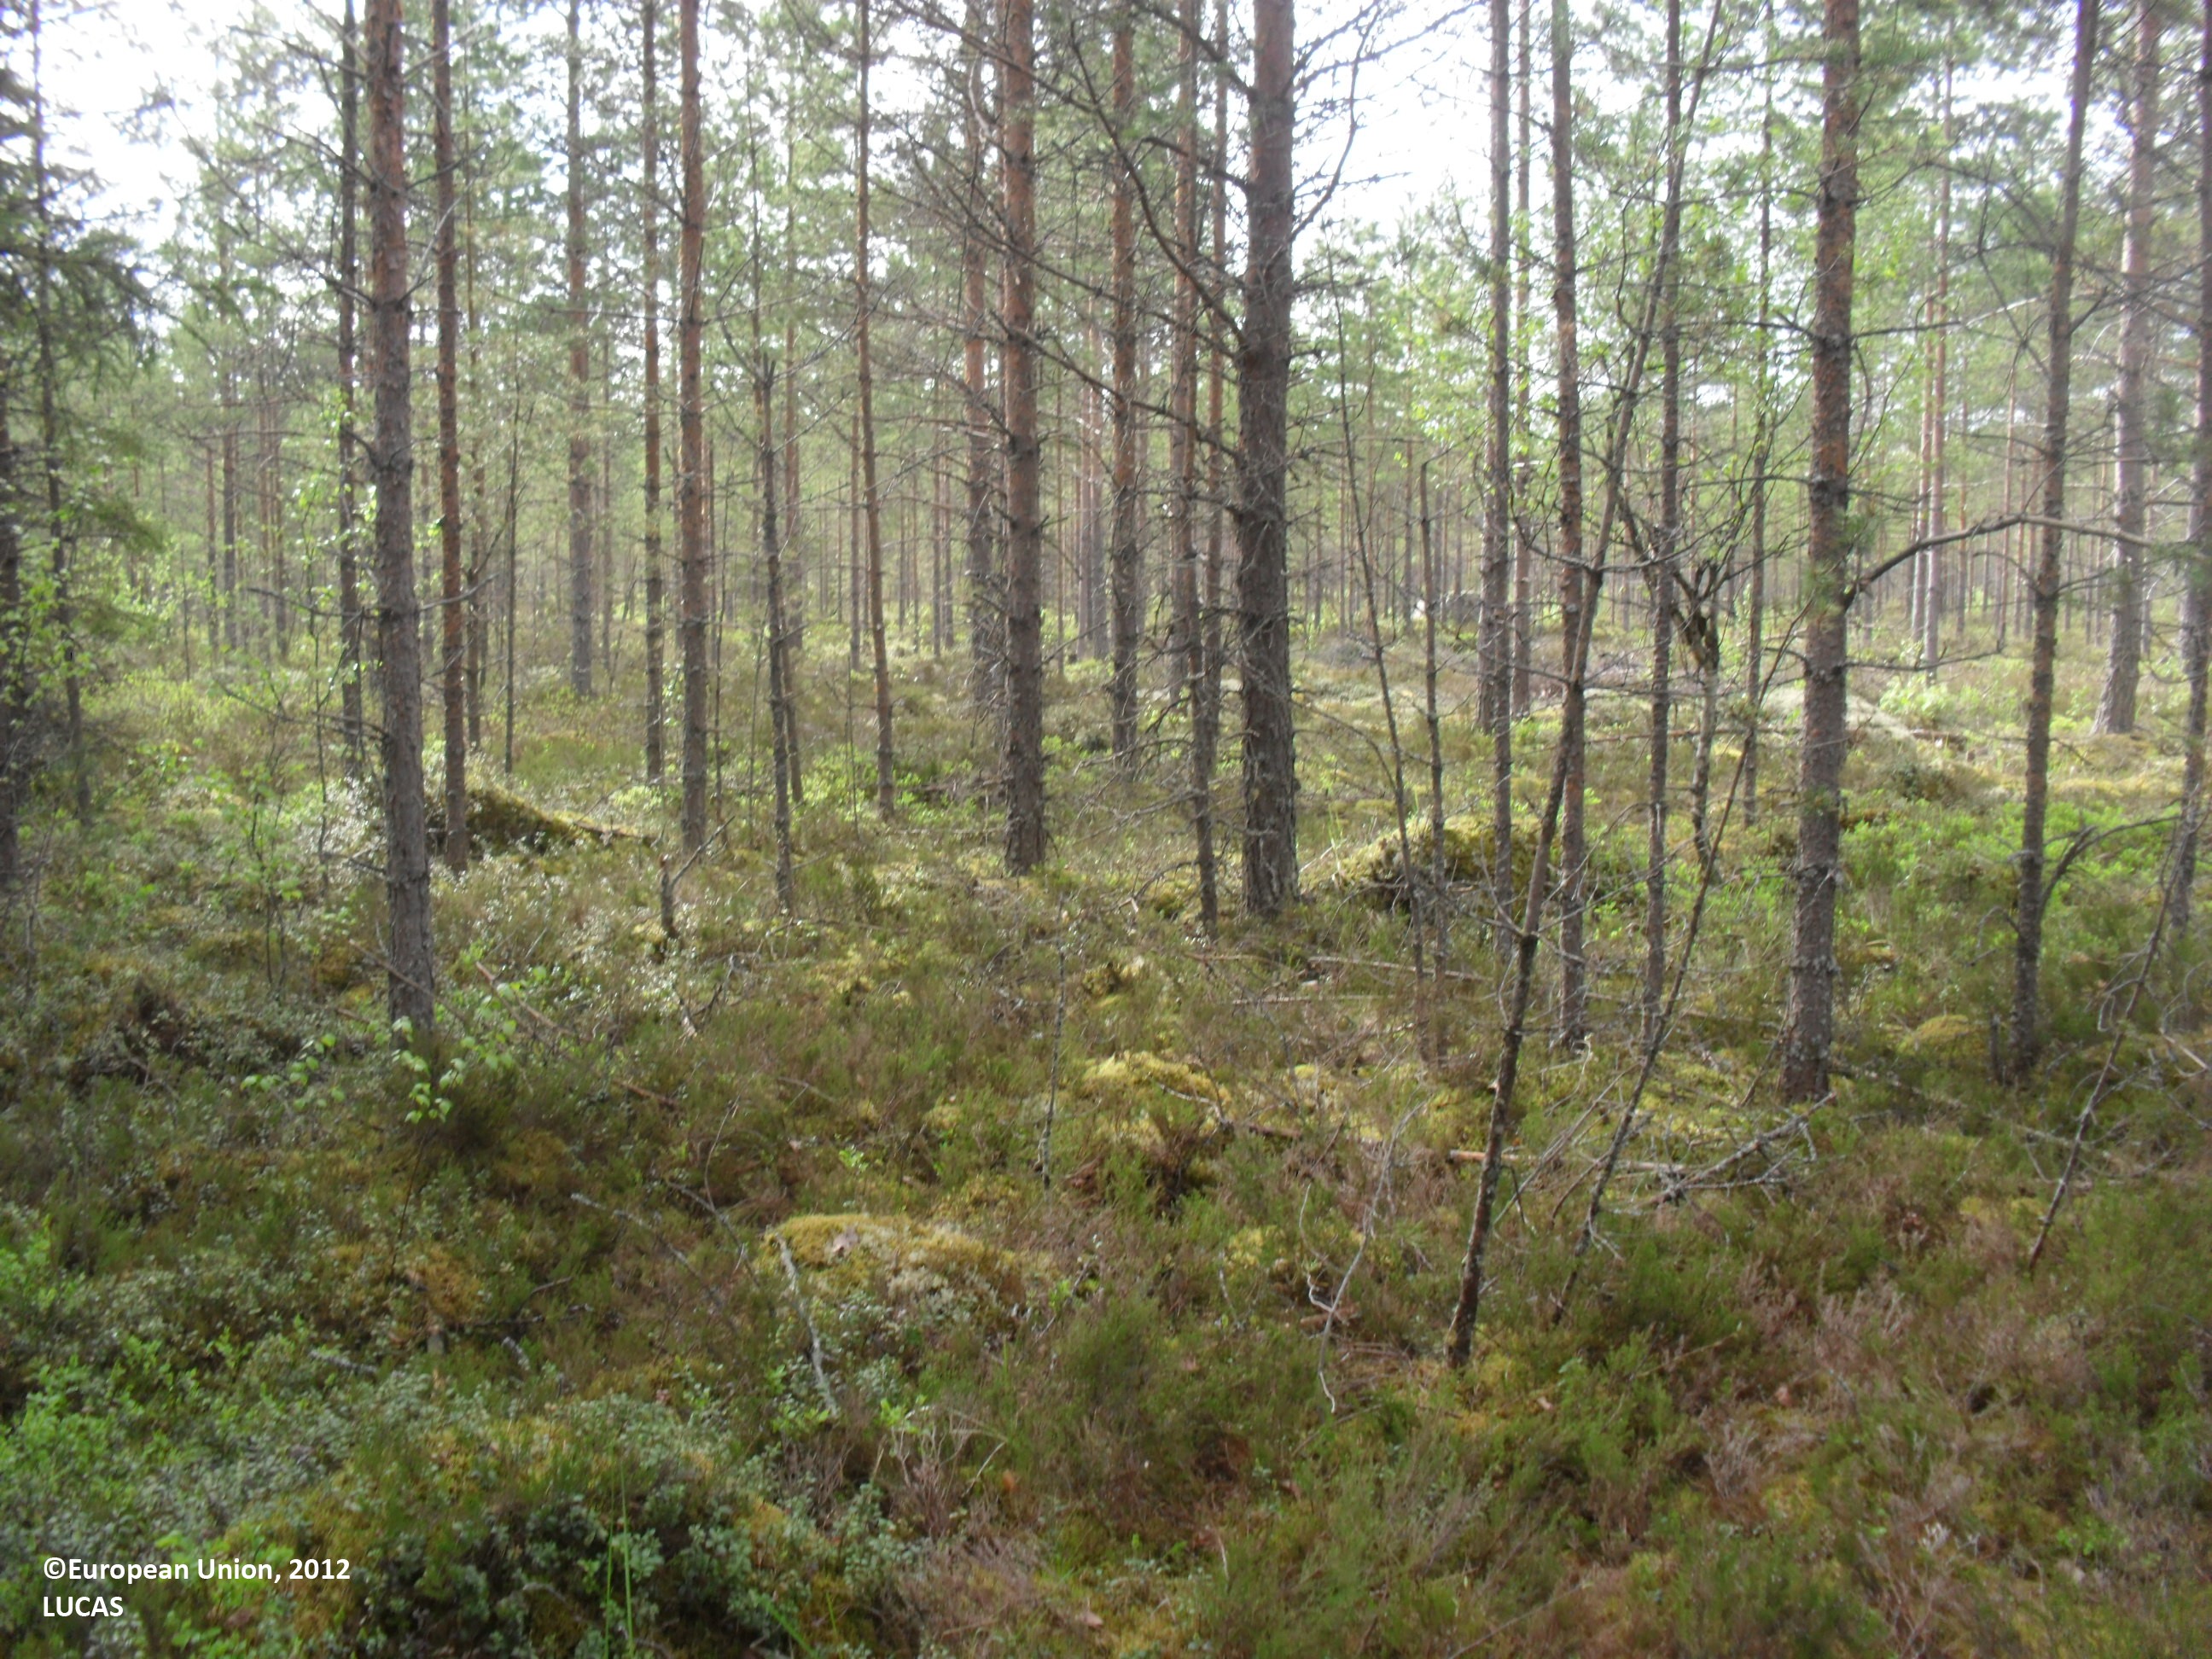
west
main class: Woodland
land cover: Pine dominated coniferous woodland
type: boreal forest
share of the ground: 50 - 75 %
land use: Forestry
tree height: > 5 m
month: June
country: FI
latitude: 62.7894
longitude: 23.2970
